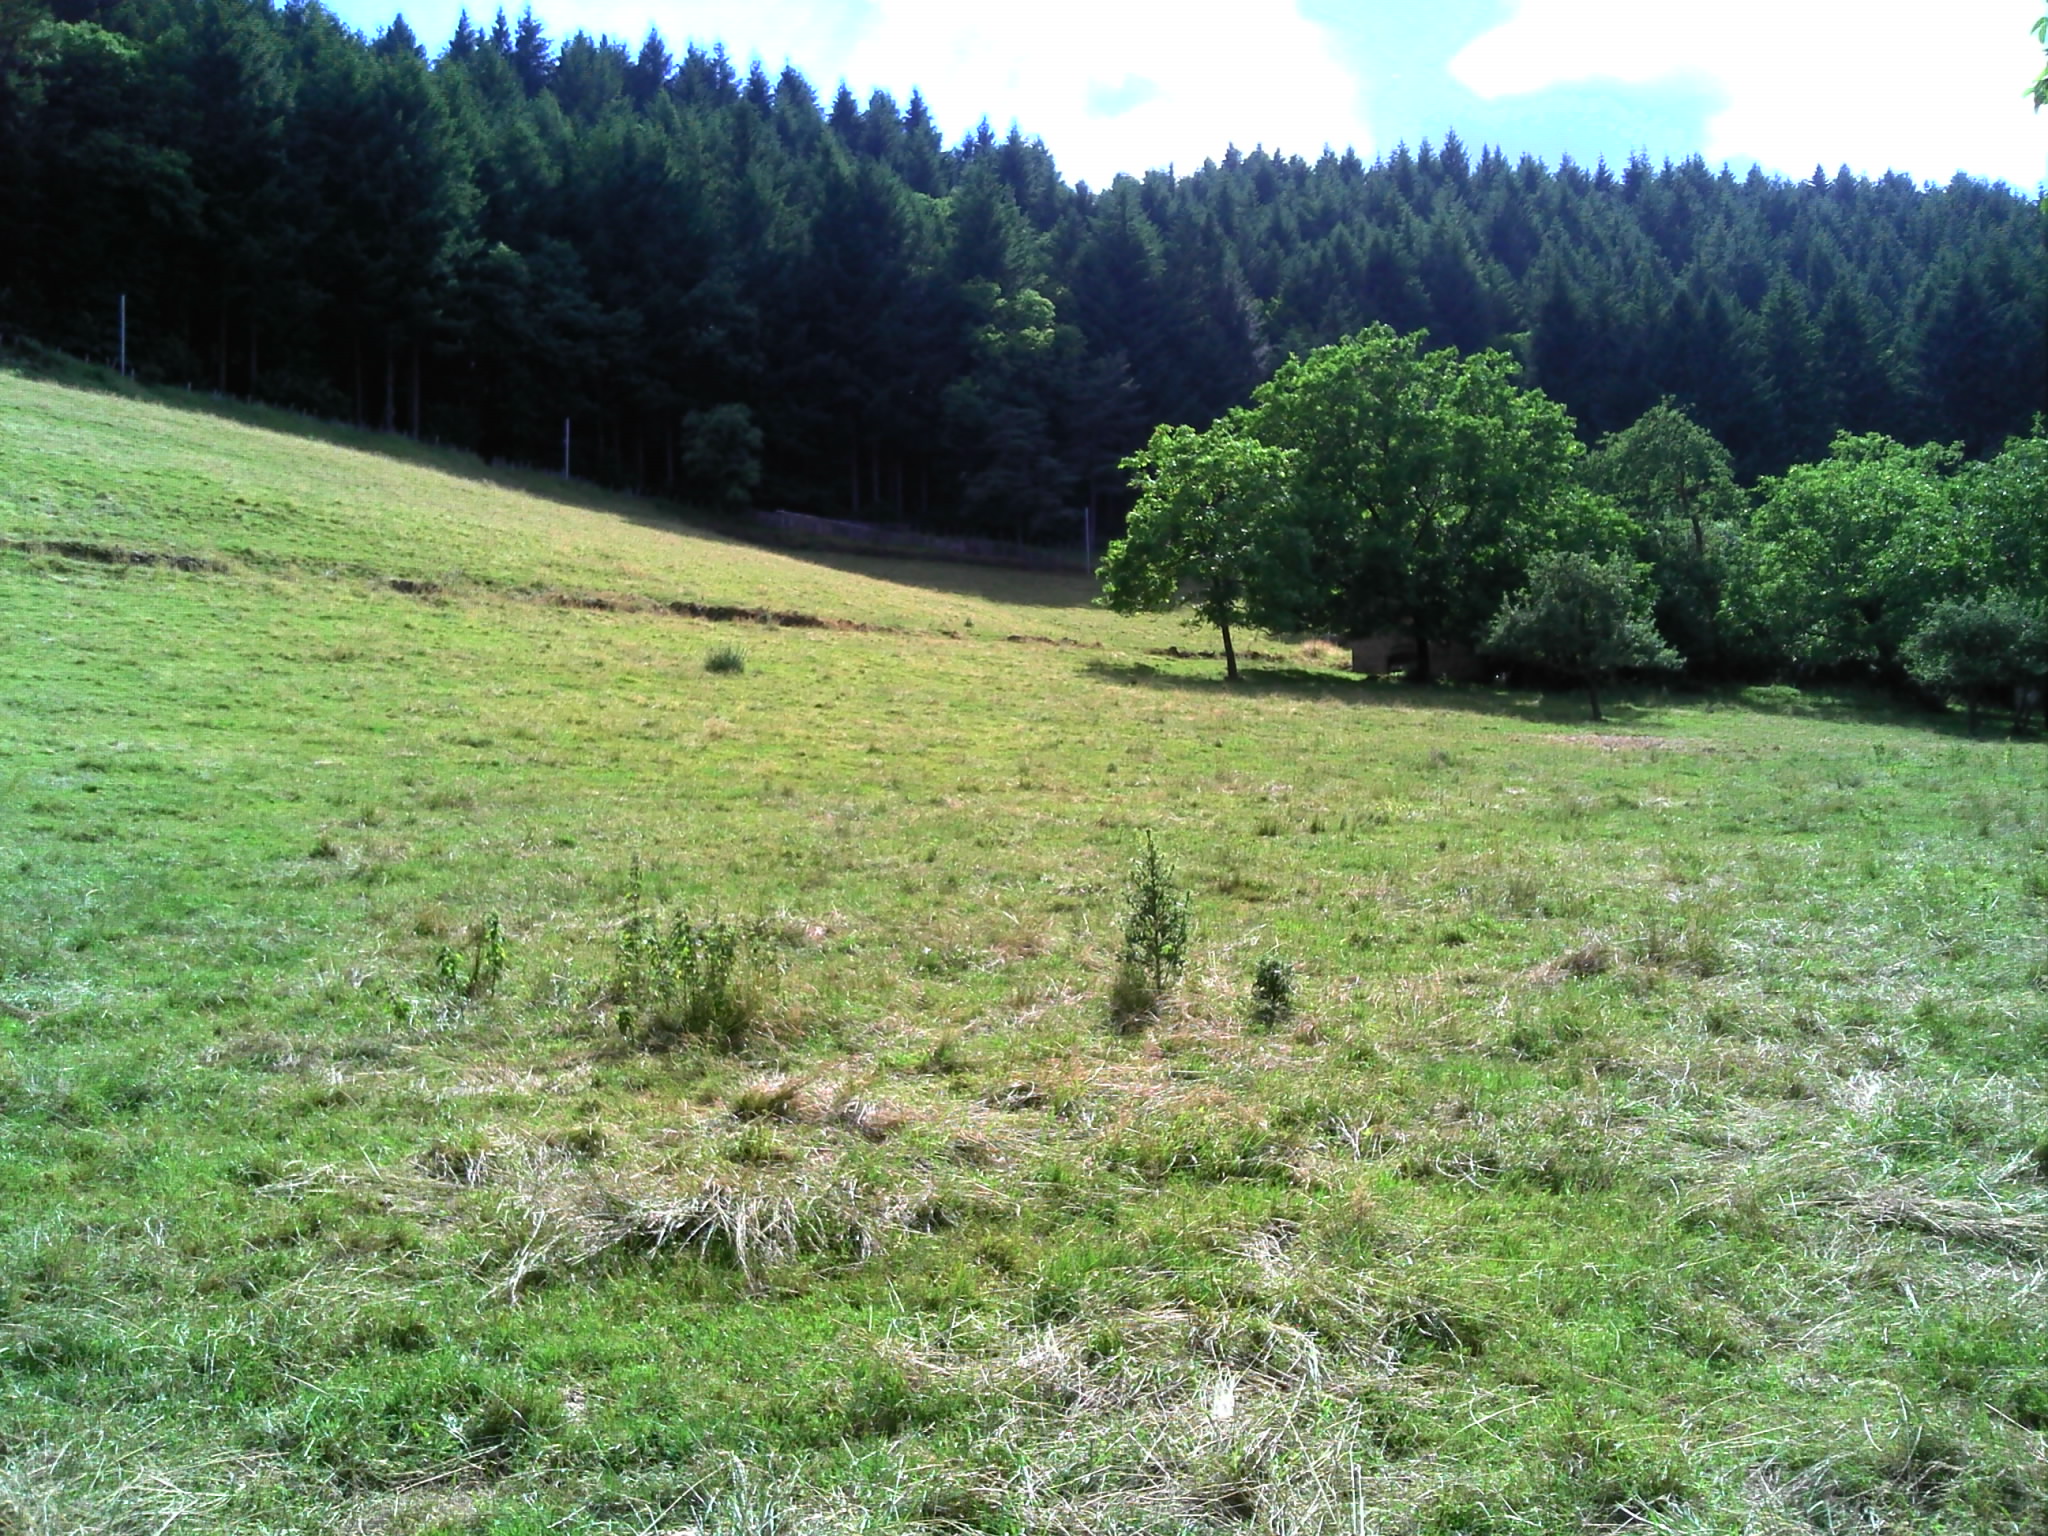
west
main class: Grassland
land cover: Grassland with sparse tree/shrub cover
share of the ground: > 75 %
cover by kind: herbaceous plants 95 %, broadleaved forest trees 5 %
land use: Agriculture (excluding fallow land and kitchen gardens)
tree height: > 5 m
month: June
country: FR
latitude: 44.8895
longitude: 1.9585
